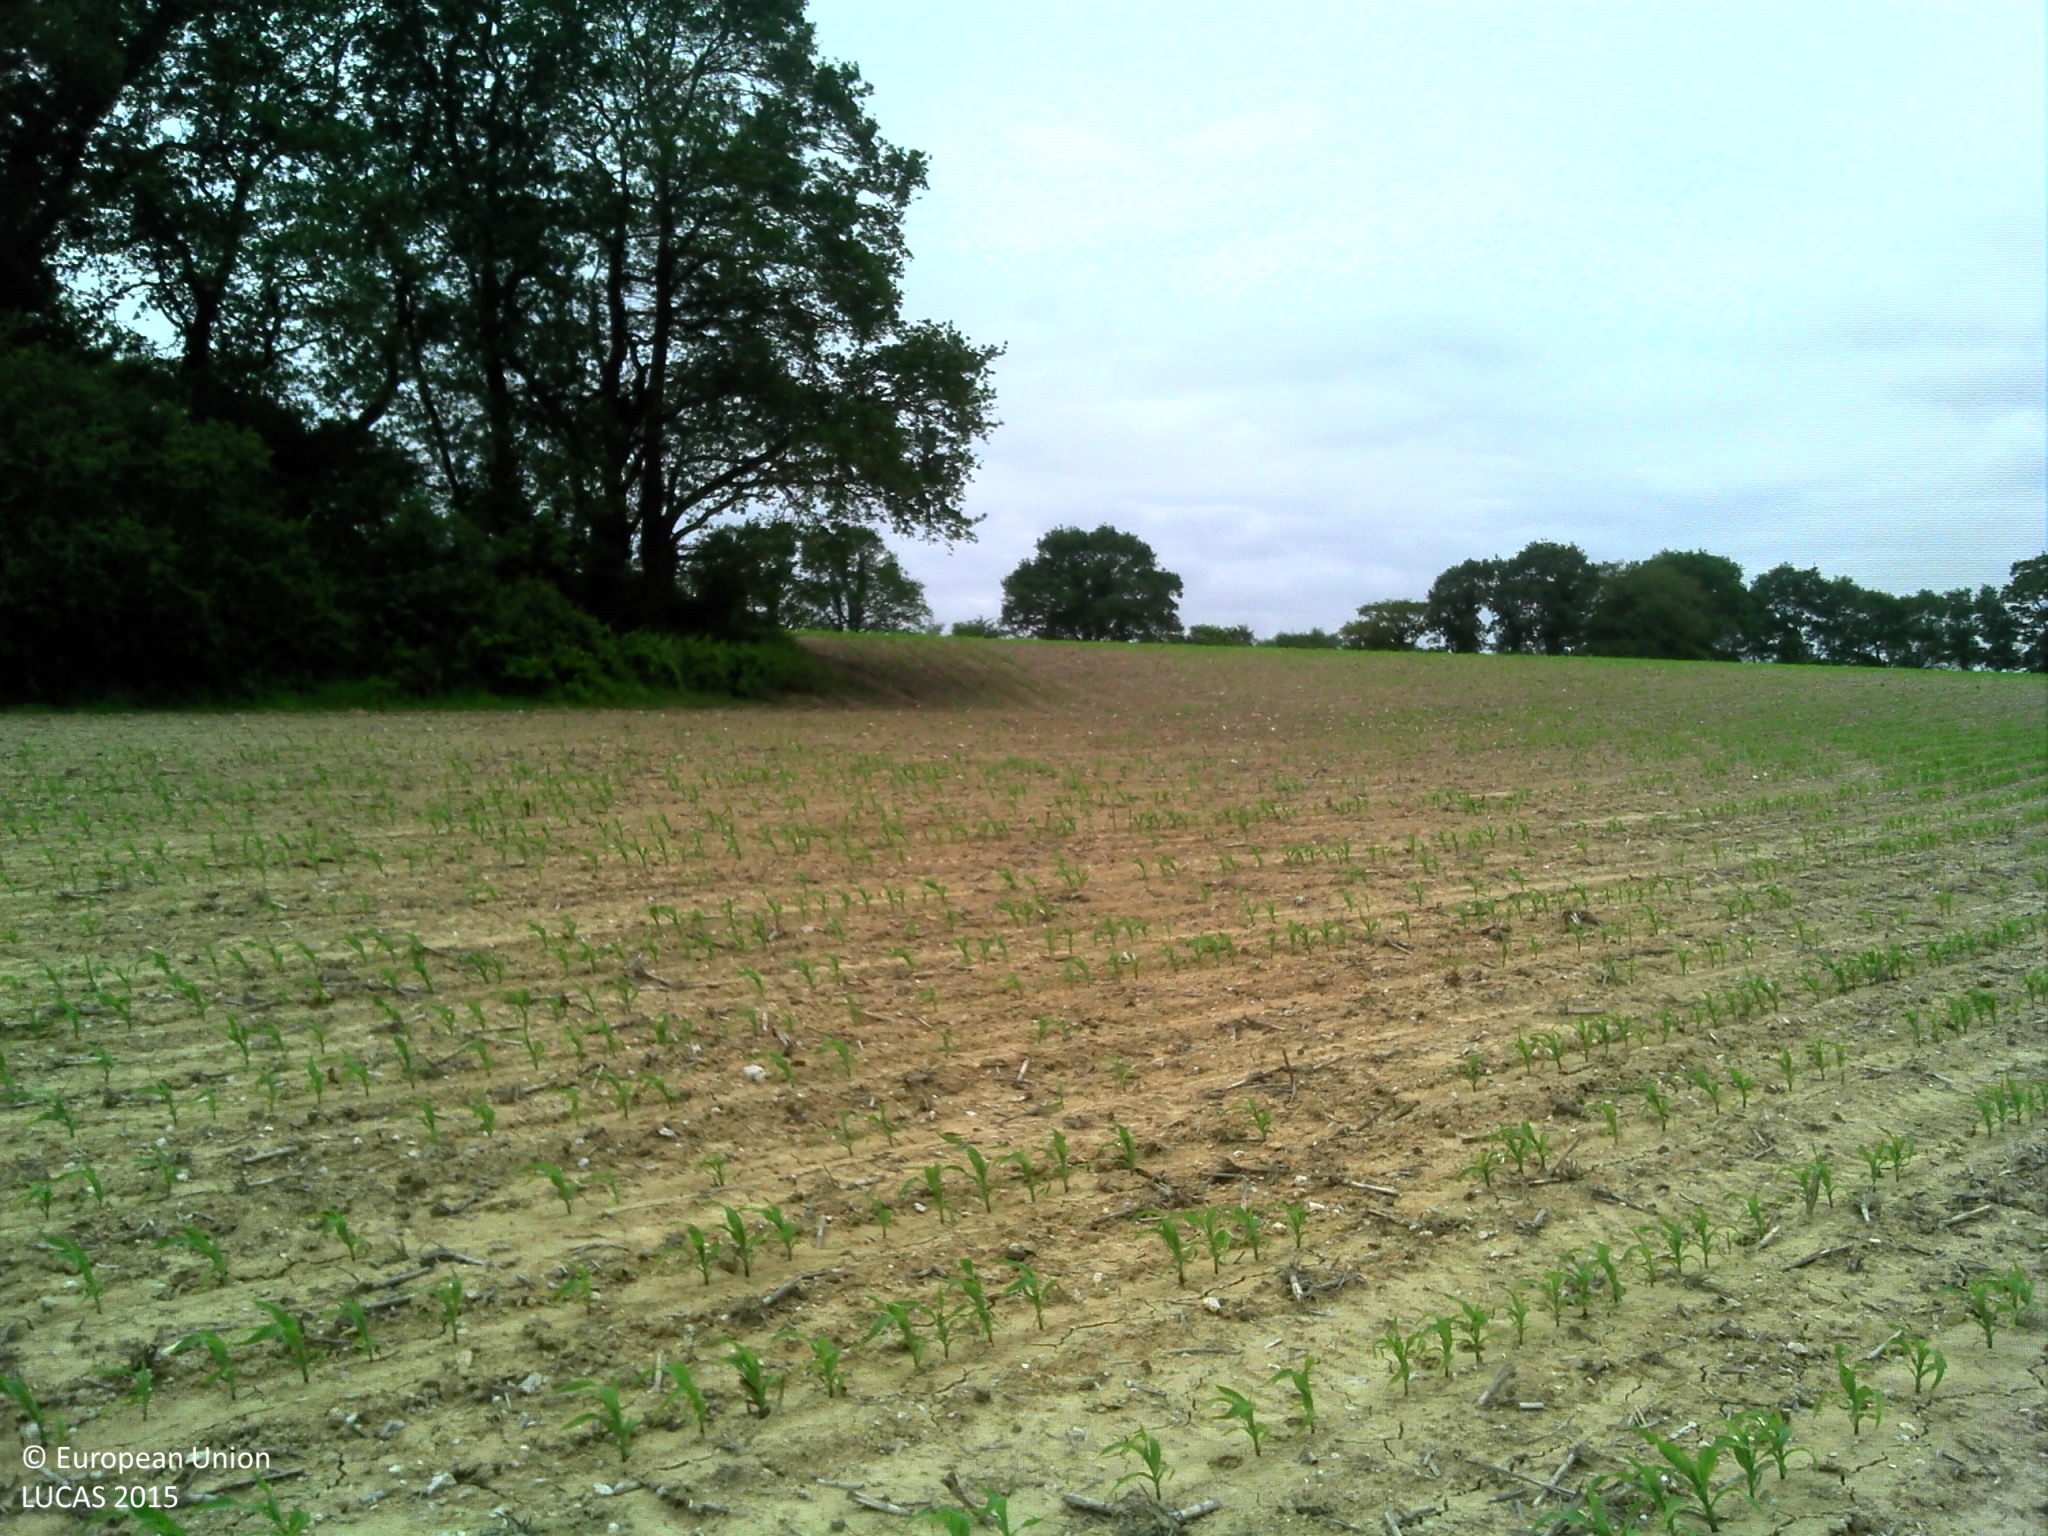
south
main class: Cropland
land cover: Maize
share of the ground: 10 - 25 %
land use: Agriculture (excluding fallow land and kitchen gardens)
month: June
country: FR
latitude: 46.8943
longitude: -1.8174
